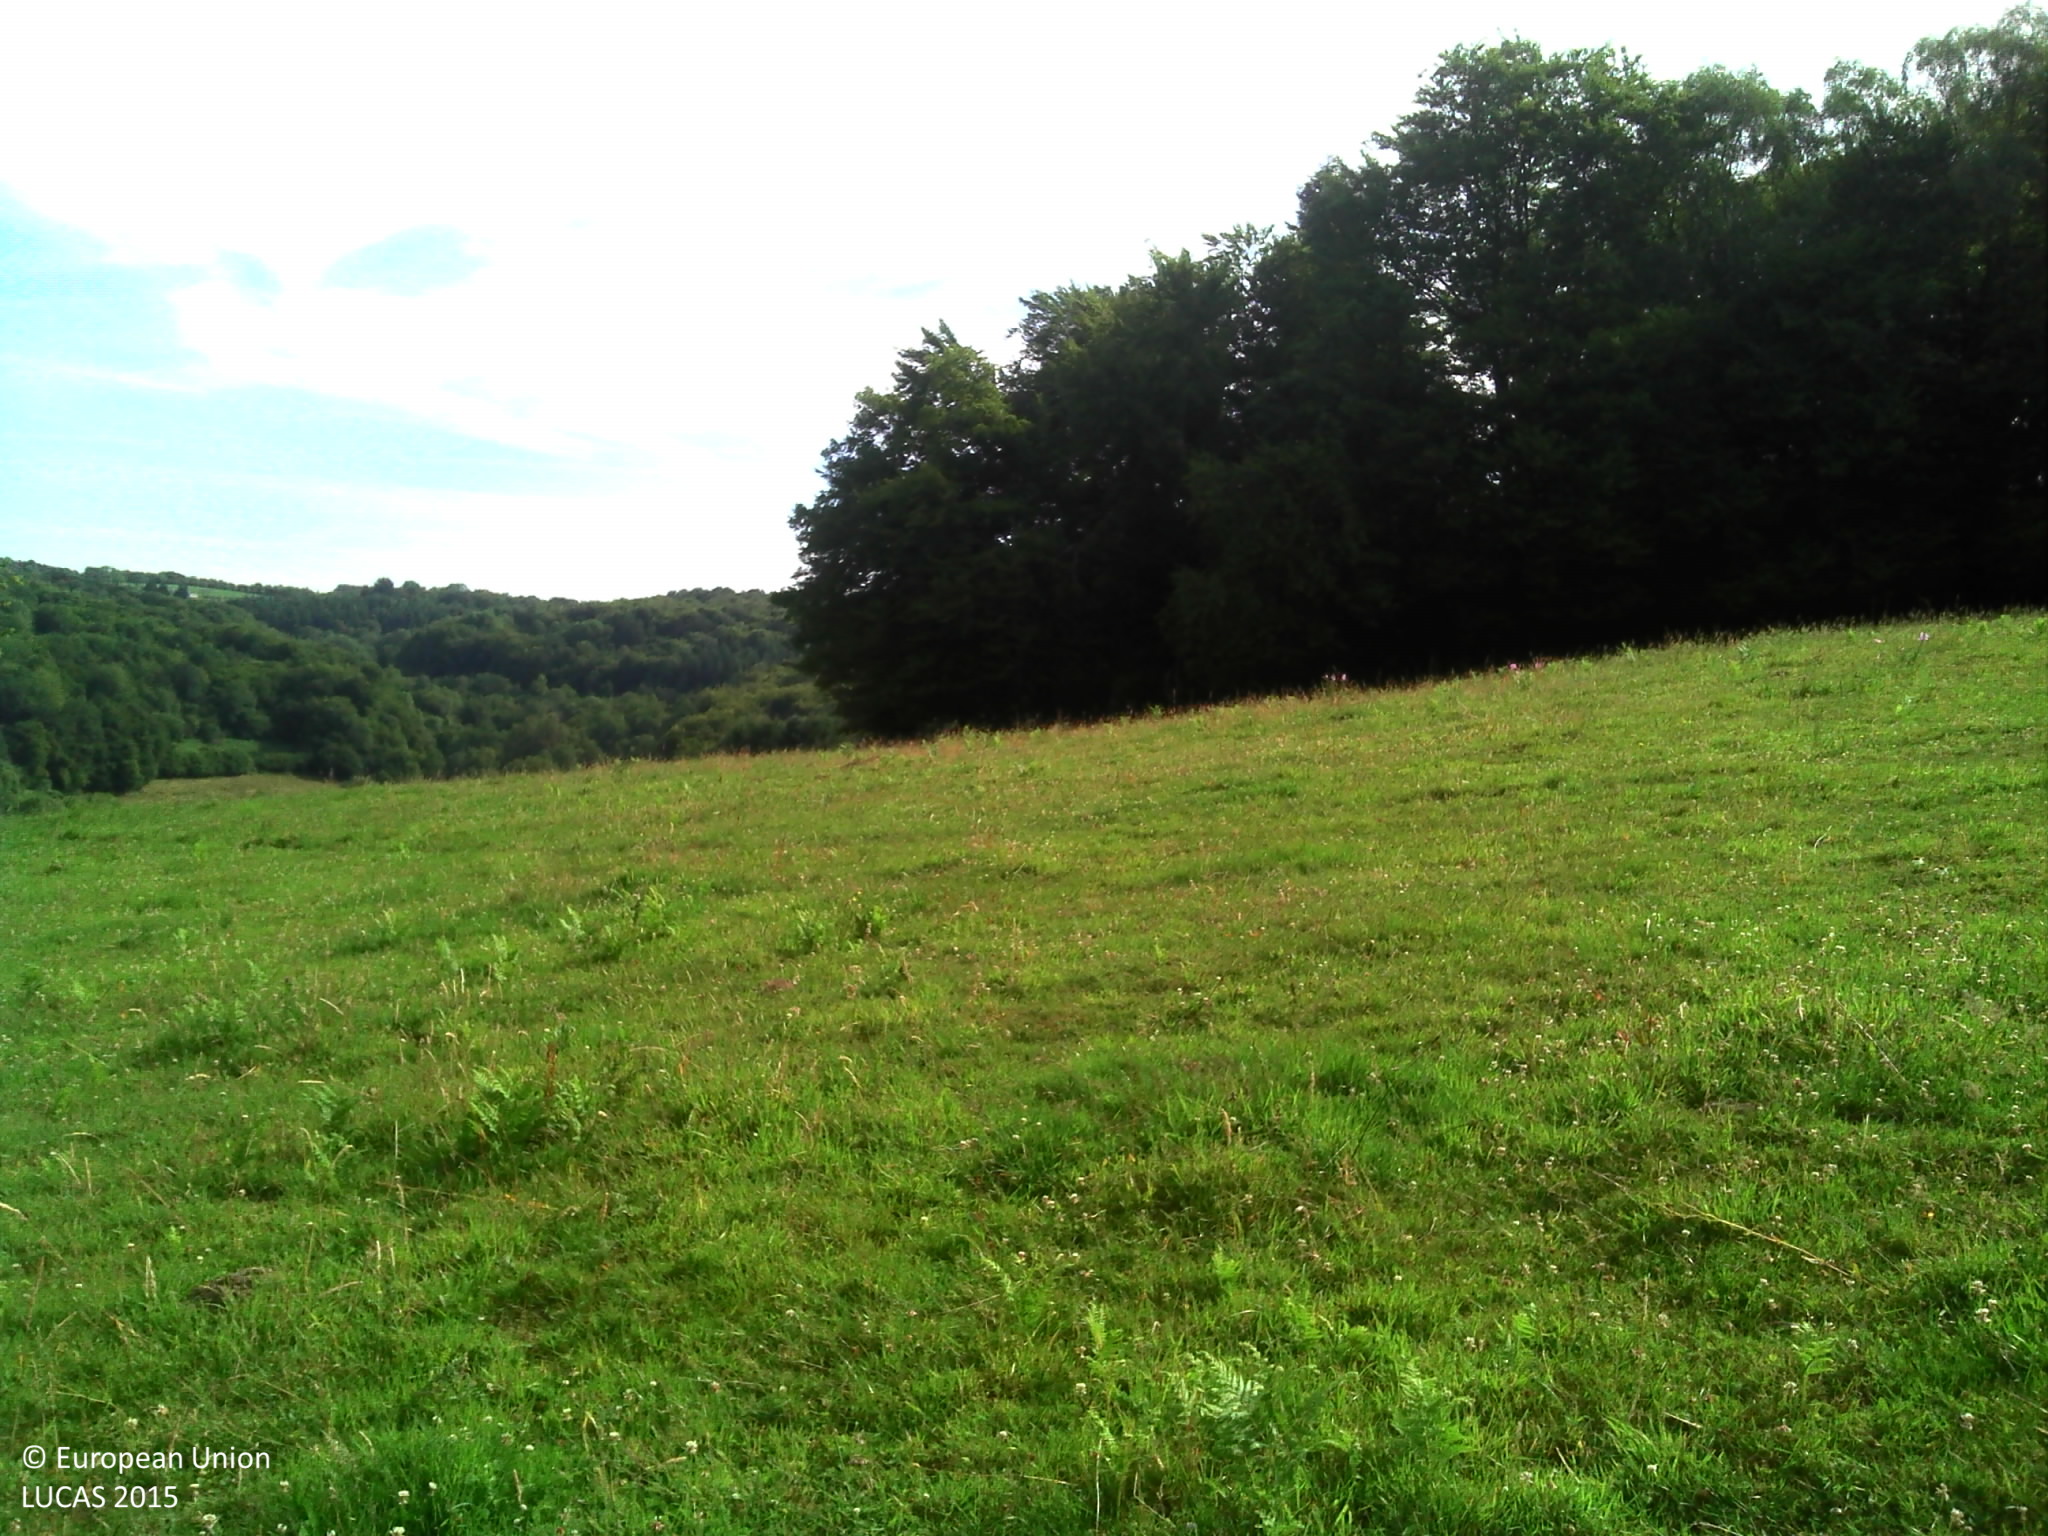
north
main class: Grassland
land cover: Grassland without tree/shrub cover
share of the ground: > 75 %
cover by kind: herbaceous plants 100 %
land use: Agriculture (excluding fallow land and kitchen gardens)
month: June
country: FR
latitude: 47.0127
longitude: 3.9874
